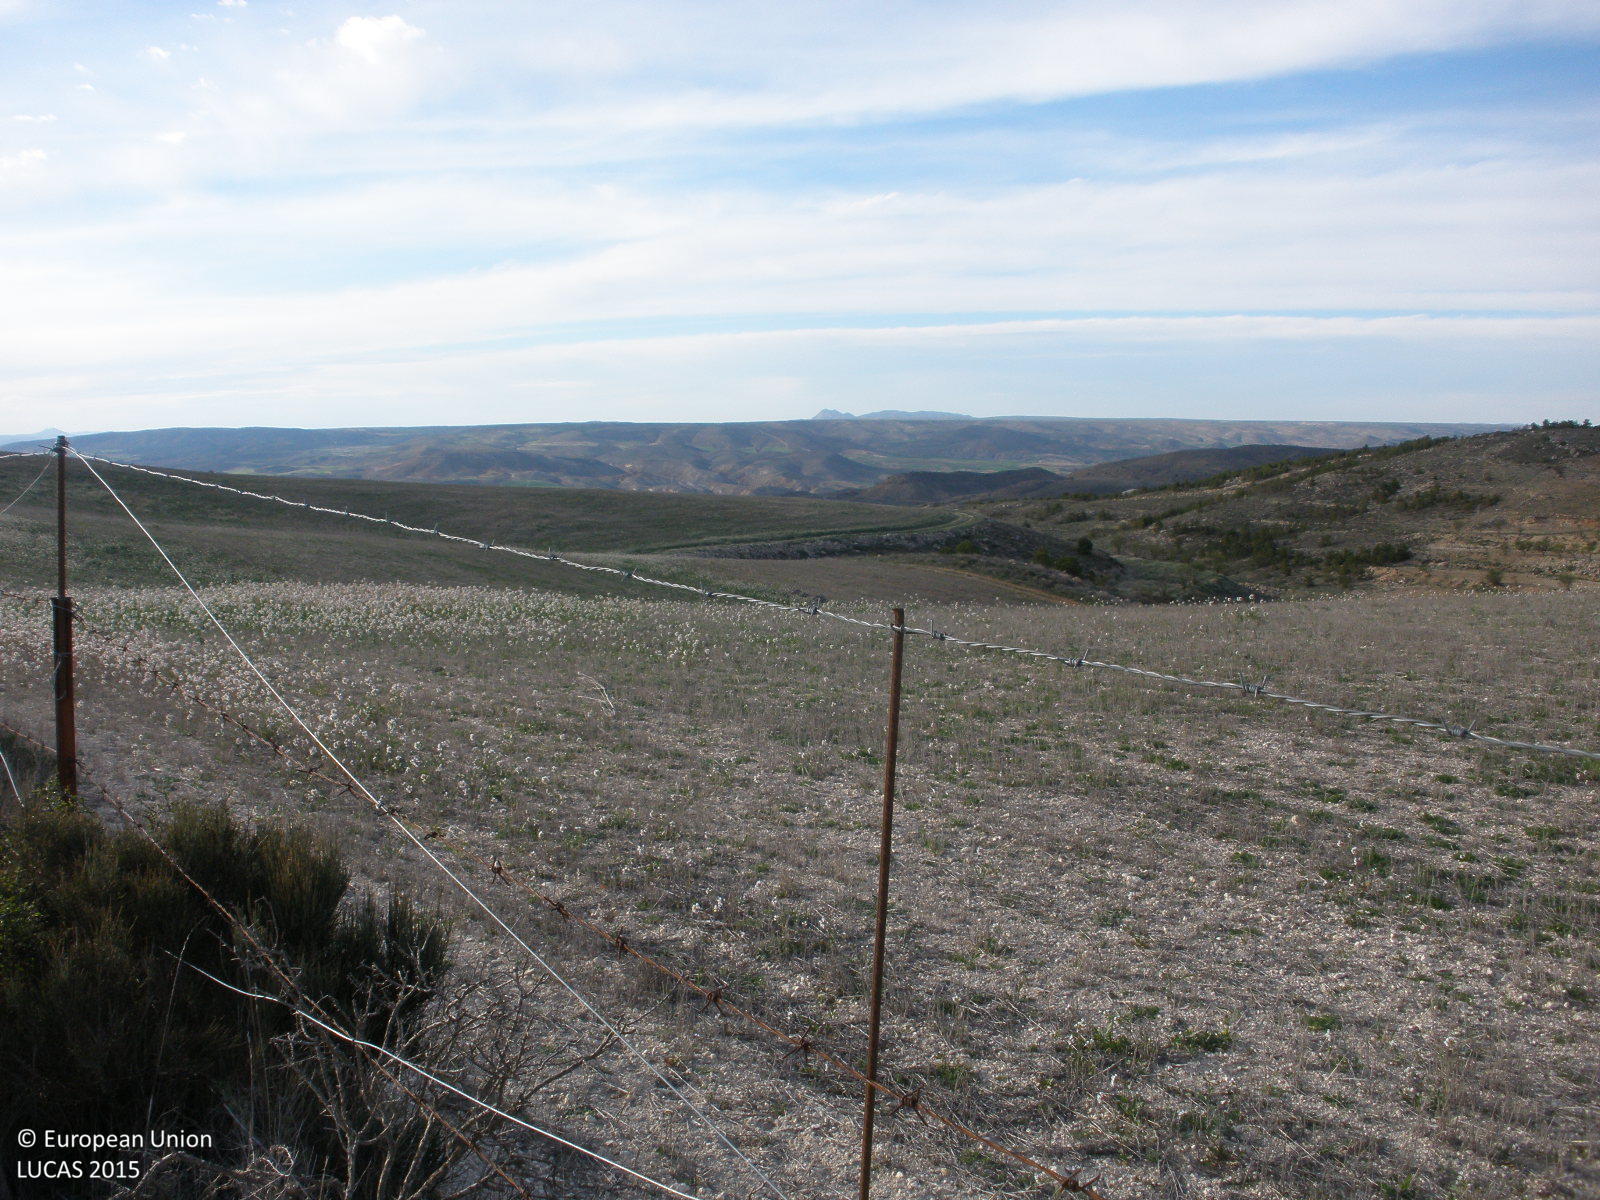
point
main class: Grassland
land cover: Spontaneously vegetated surfaces
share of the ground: > 75 %
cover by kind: herbaceous plants 70 %, unconsolidated bare surface 30 %
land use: Agriculture (excluding fallow land and kitchen gardens)
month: April
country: ES
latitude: 40.3508
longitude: -1.0659
